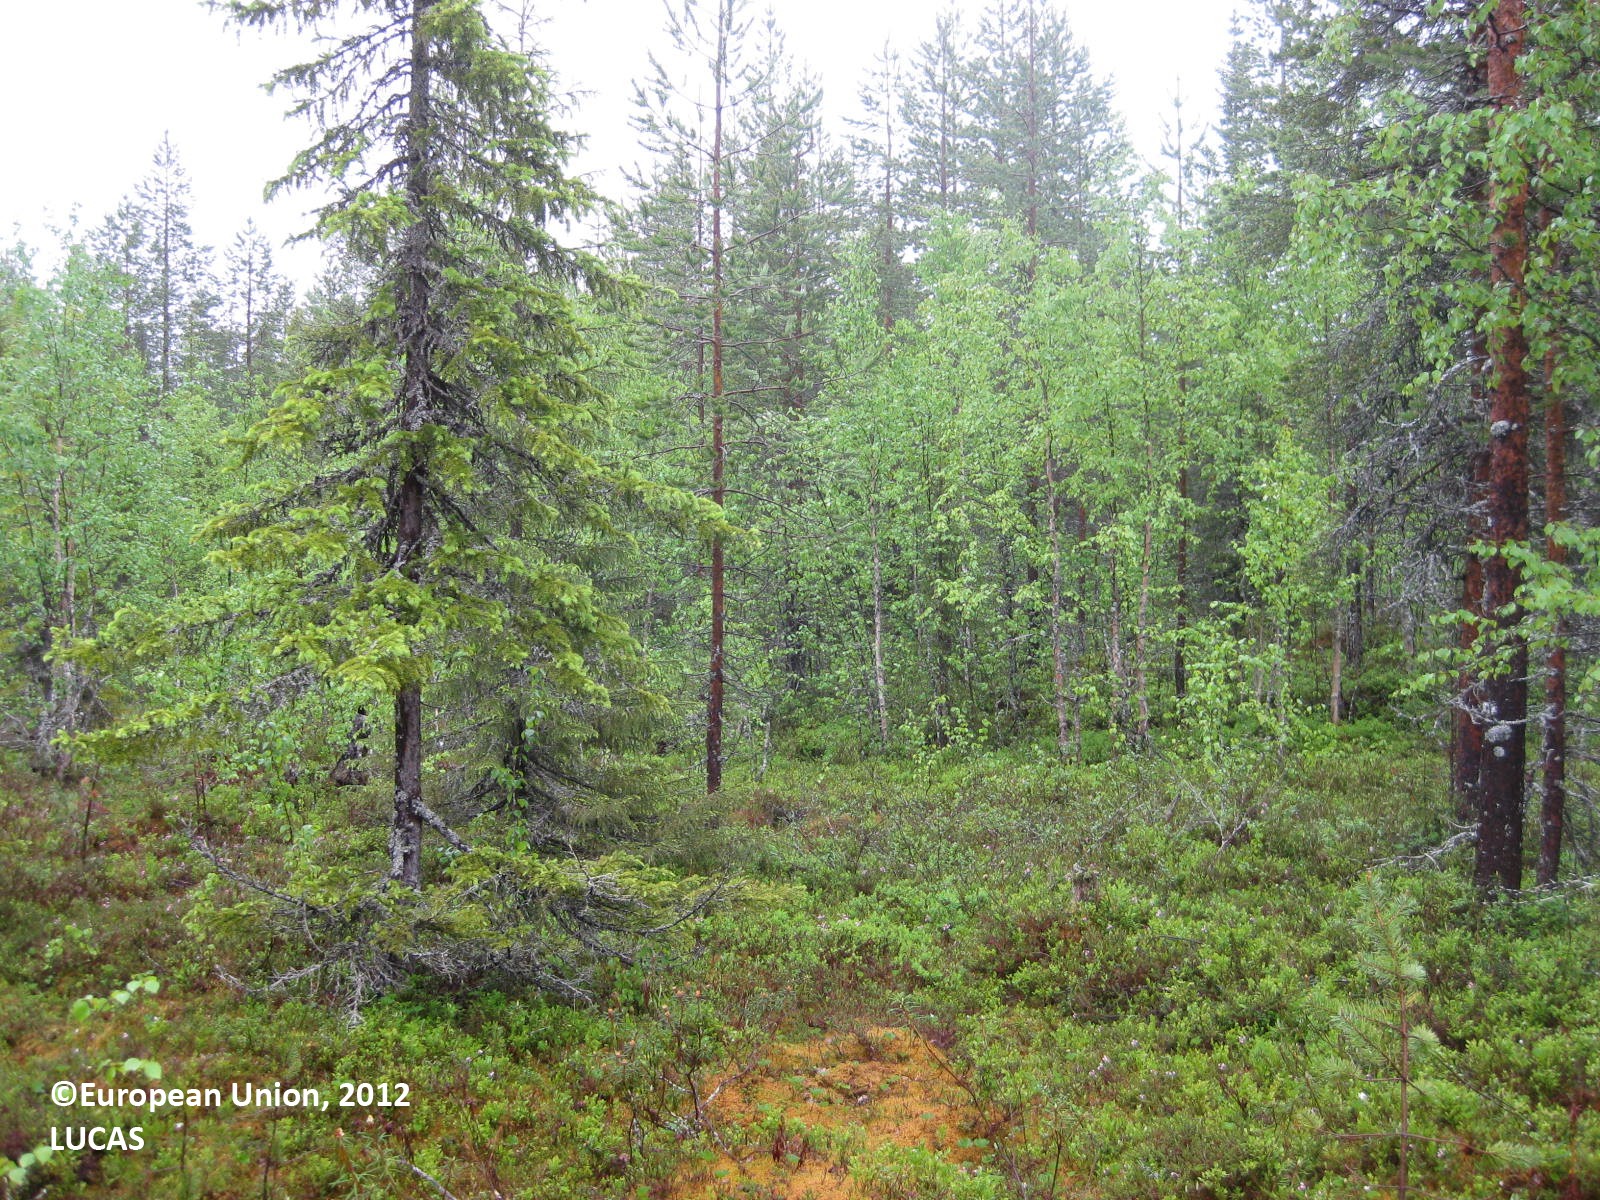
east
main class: Woodland
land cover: Other mixed woodland
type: boreal forest
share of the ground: 50 - 75 %
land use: Forestry
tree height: > 5 m
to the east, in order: Other mixed woodland; Ditches and canals; Pine dominated mixed woodland; Other mixed woodland; Pine dominated mixed woodland; Other mixed woodland; Ditches and canals; Pine dominated mixed woodland; Ditches and canals; Other mixed woodland; Pine dominated mixed woodland; Ditches and canals; Pine dominated mixed woodland
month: June
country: FI
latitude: 65.3449
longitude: 29.0240
